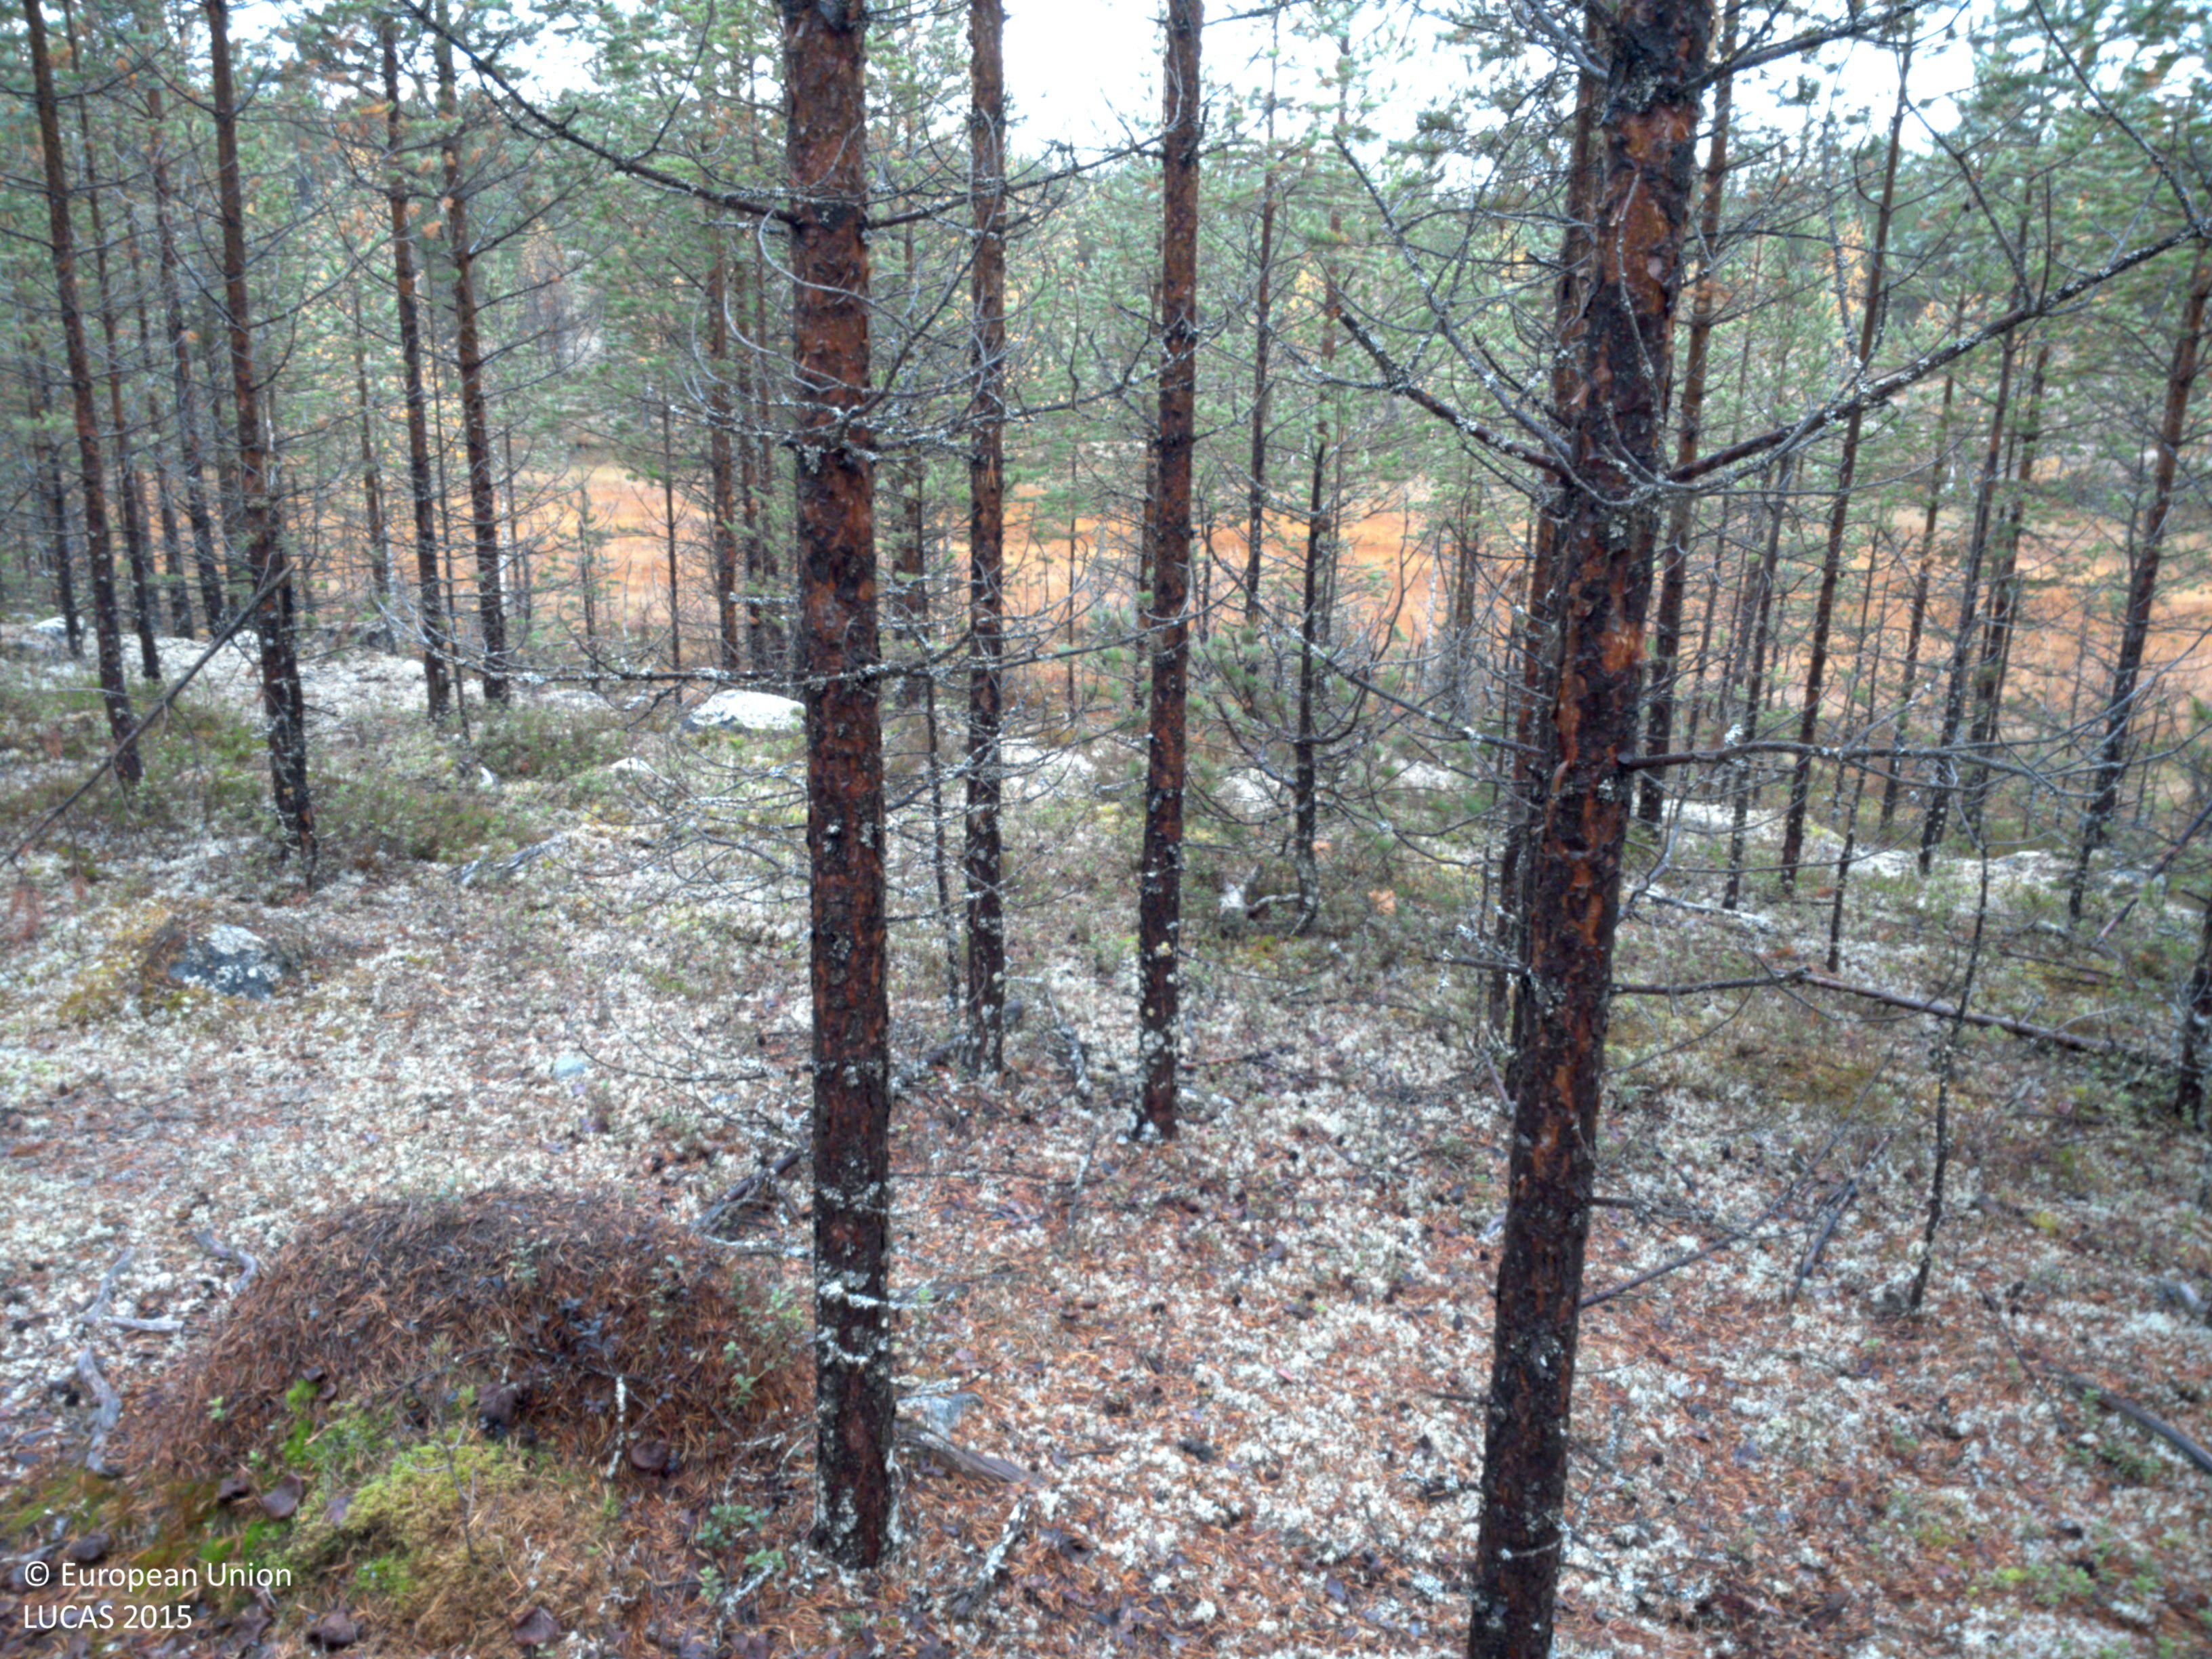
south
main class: Woodland
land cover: Pine dominated coniferous woodland
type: boreal forest
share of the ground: > 75 %
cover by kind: coniferous forest trees 80 %, shrubs 10 %, lichens and mosses 10 %
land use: Forestry
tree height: > 5 m
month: September
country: SE
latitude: 64.7323
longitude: 19.1860
